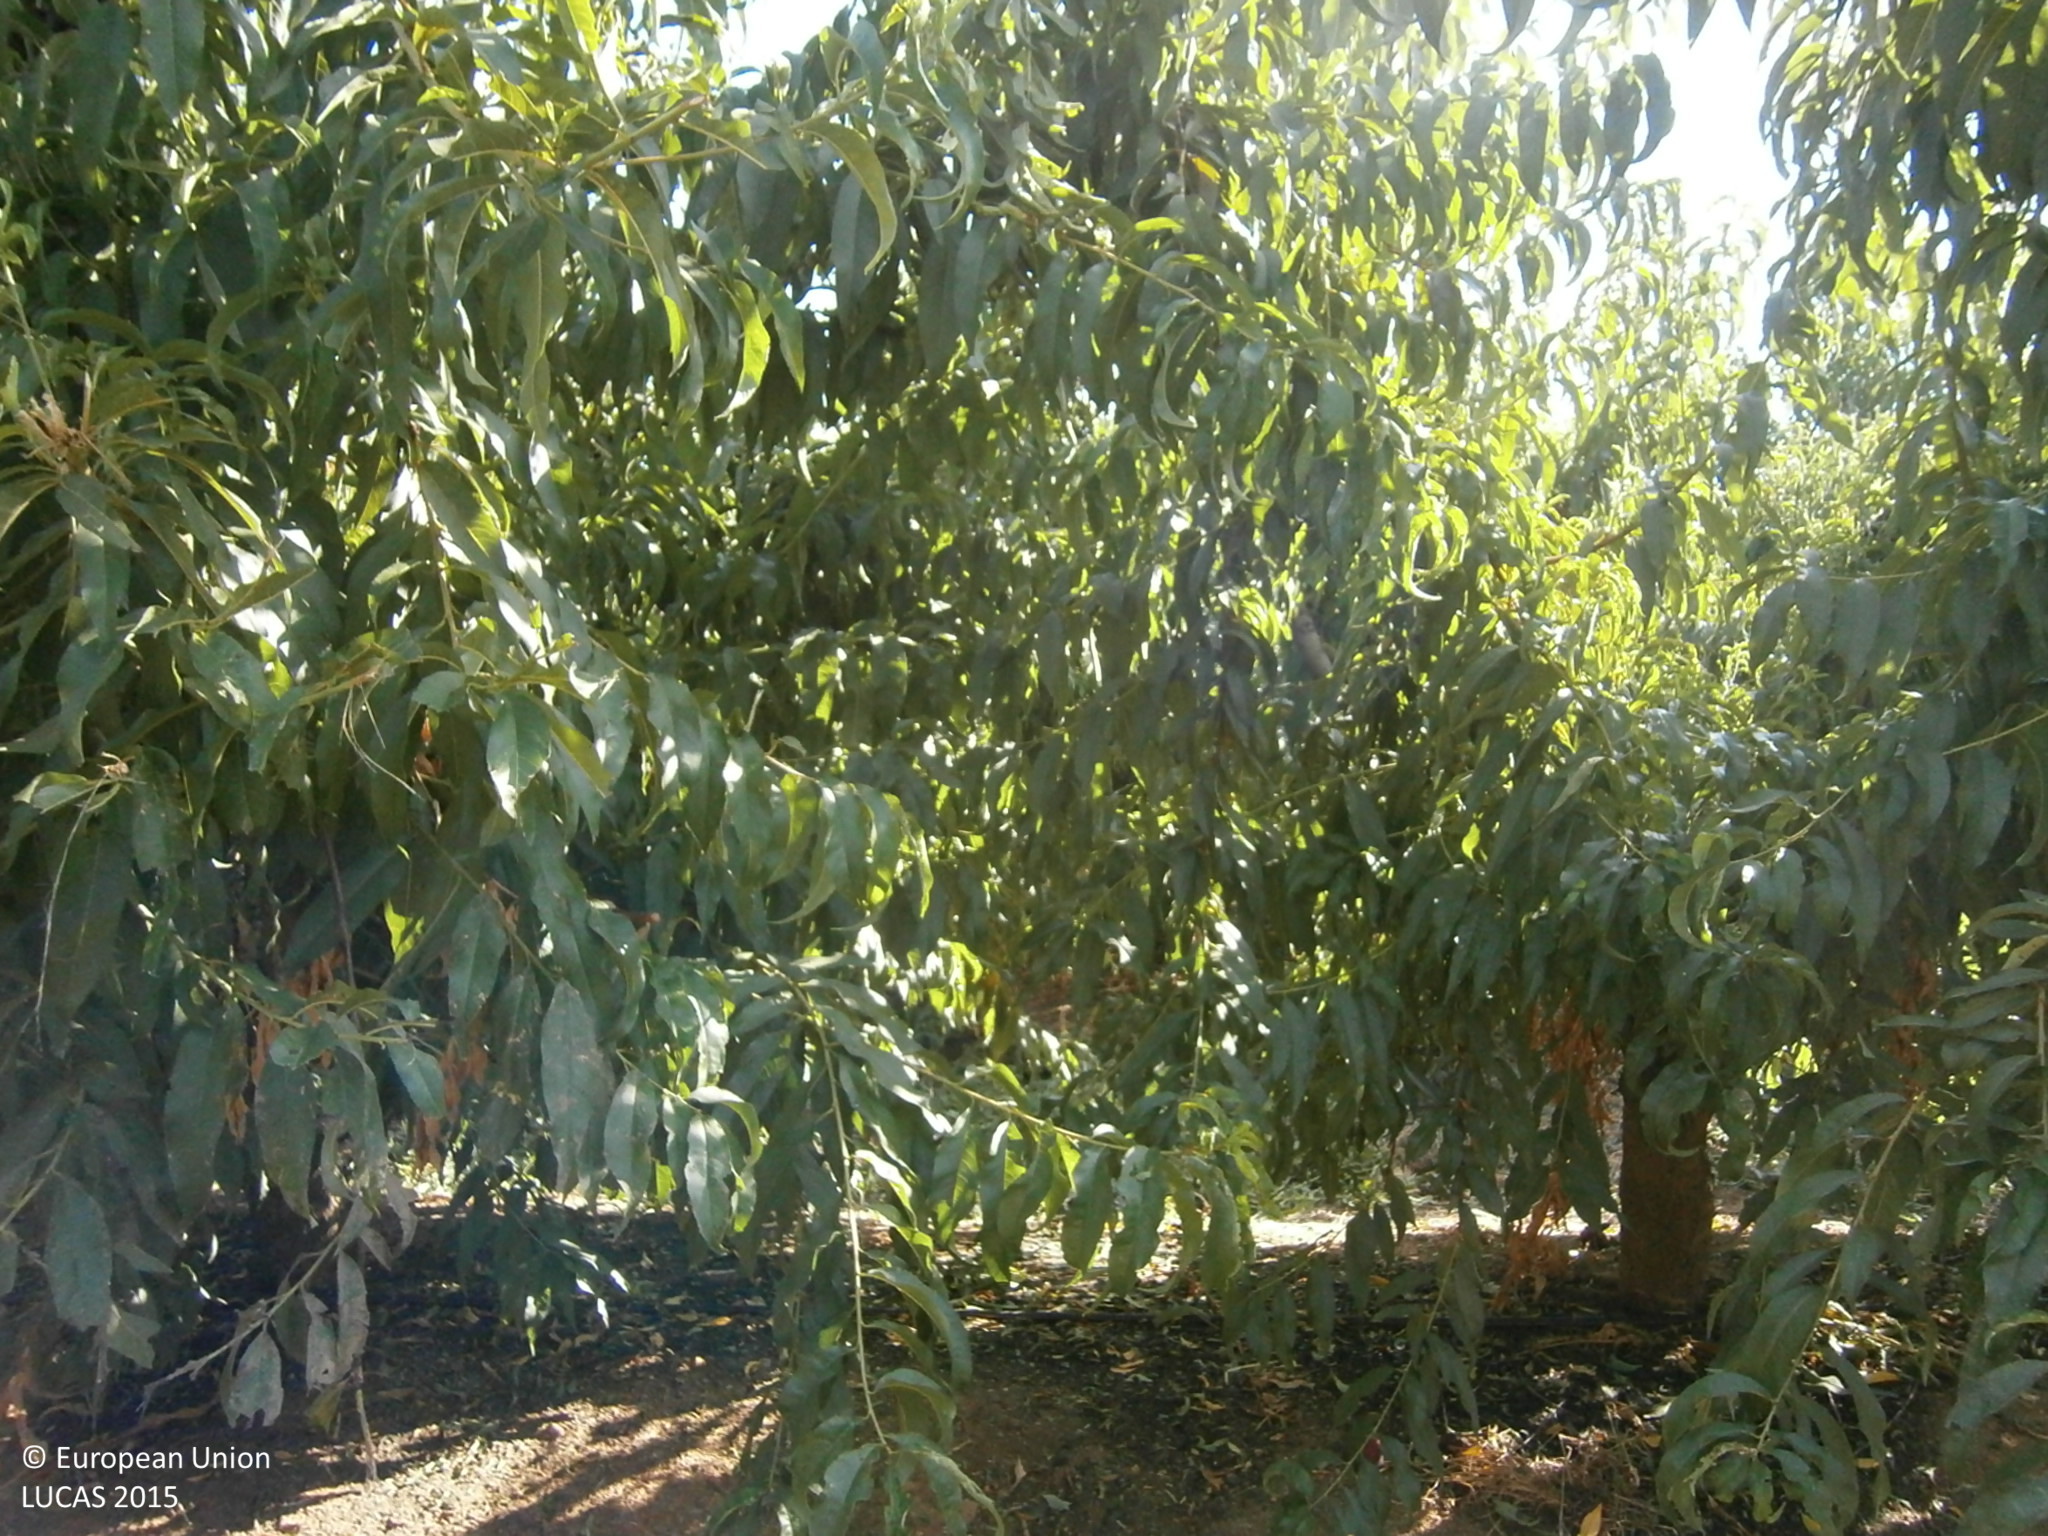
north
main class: Cropland
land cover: Other fruit trees and berries
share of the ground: 25 - 50 %
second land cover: Spontaneously vegetated surfaces
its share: 25 - 50 %
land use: Agriculture (excluding fallow land and kitchen gardens)
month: July
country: ES
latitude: 38.9326
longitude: -6.9235
